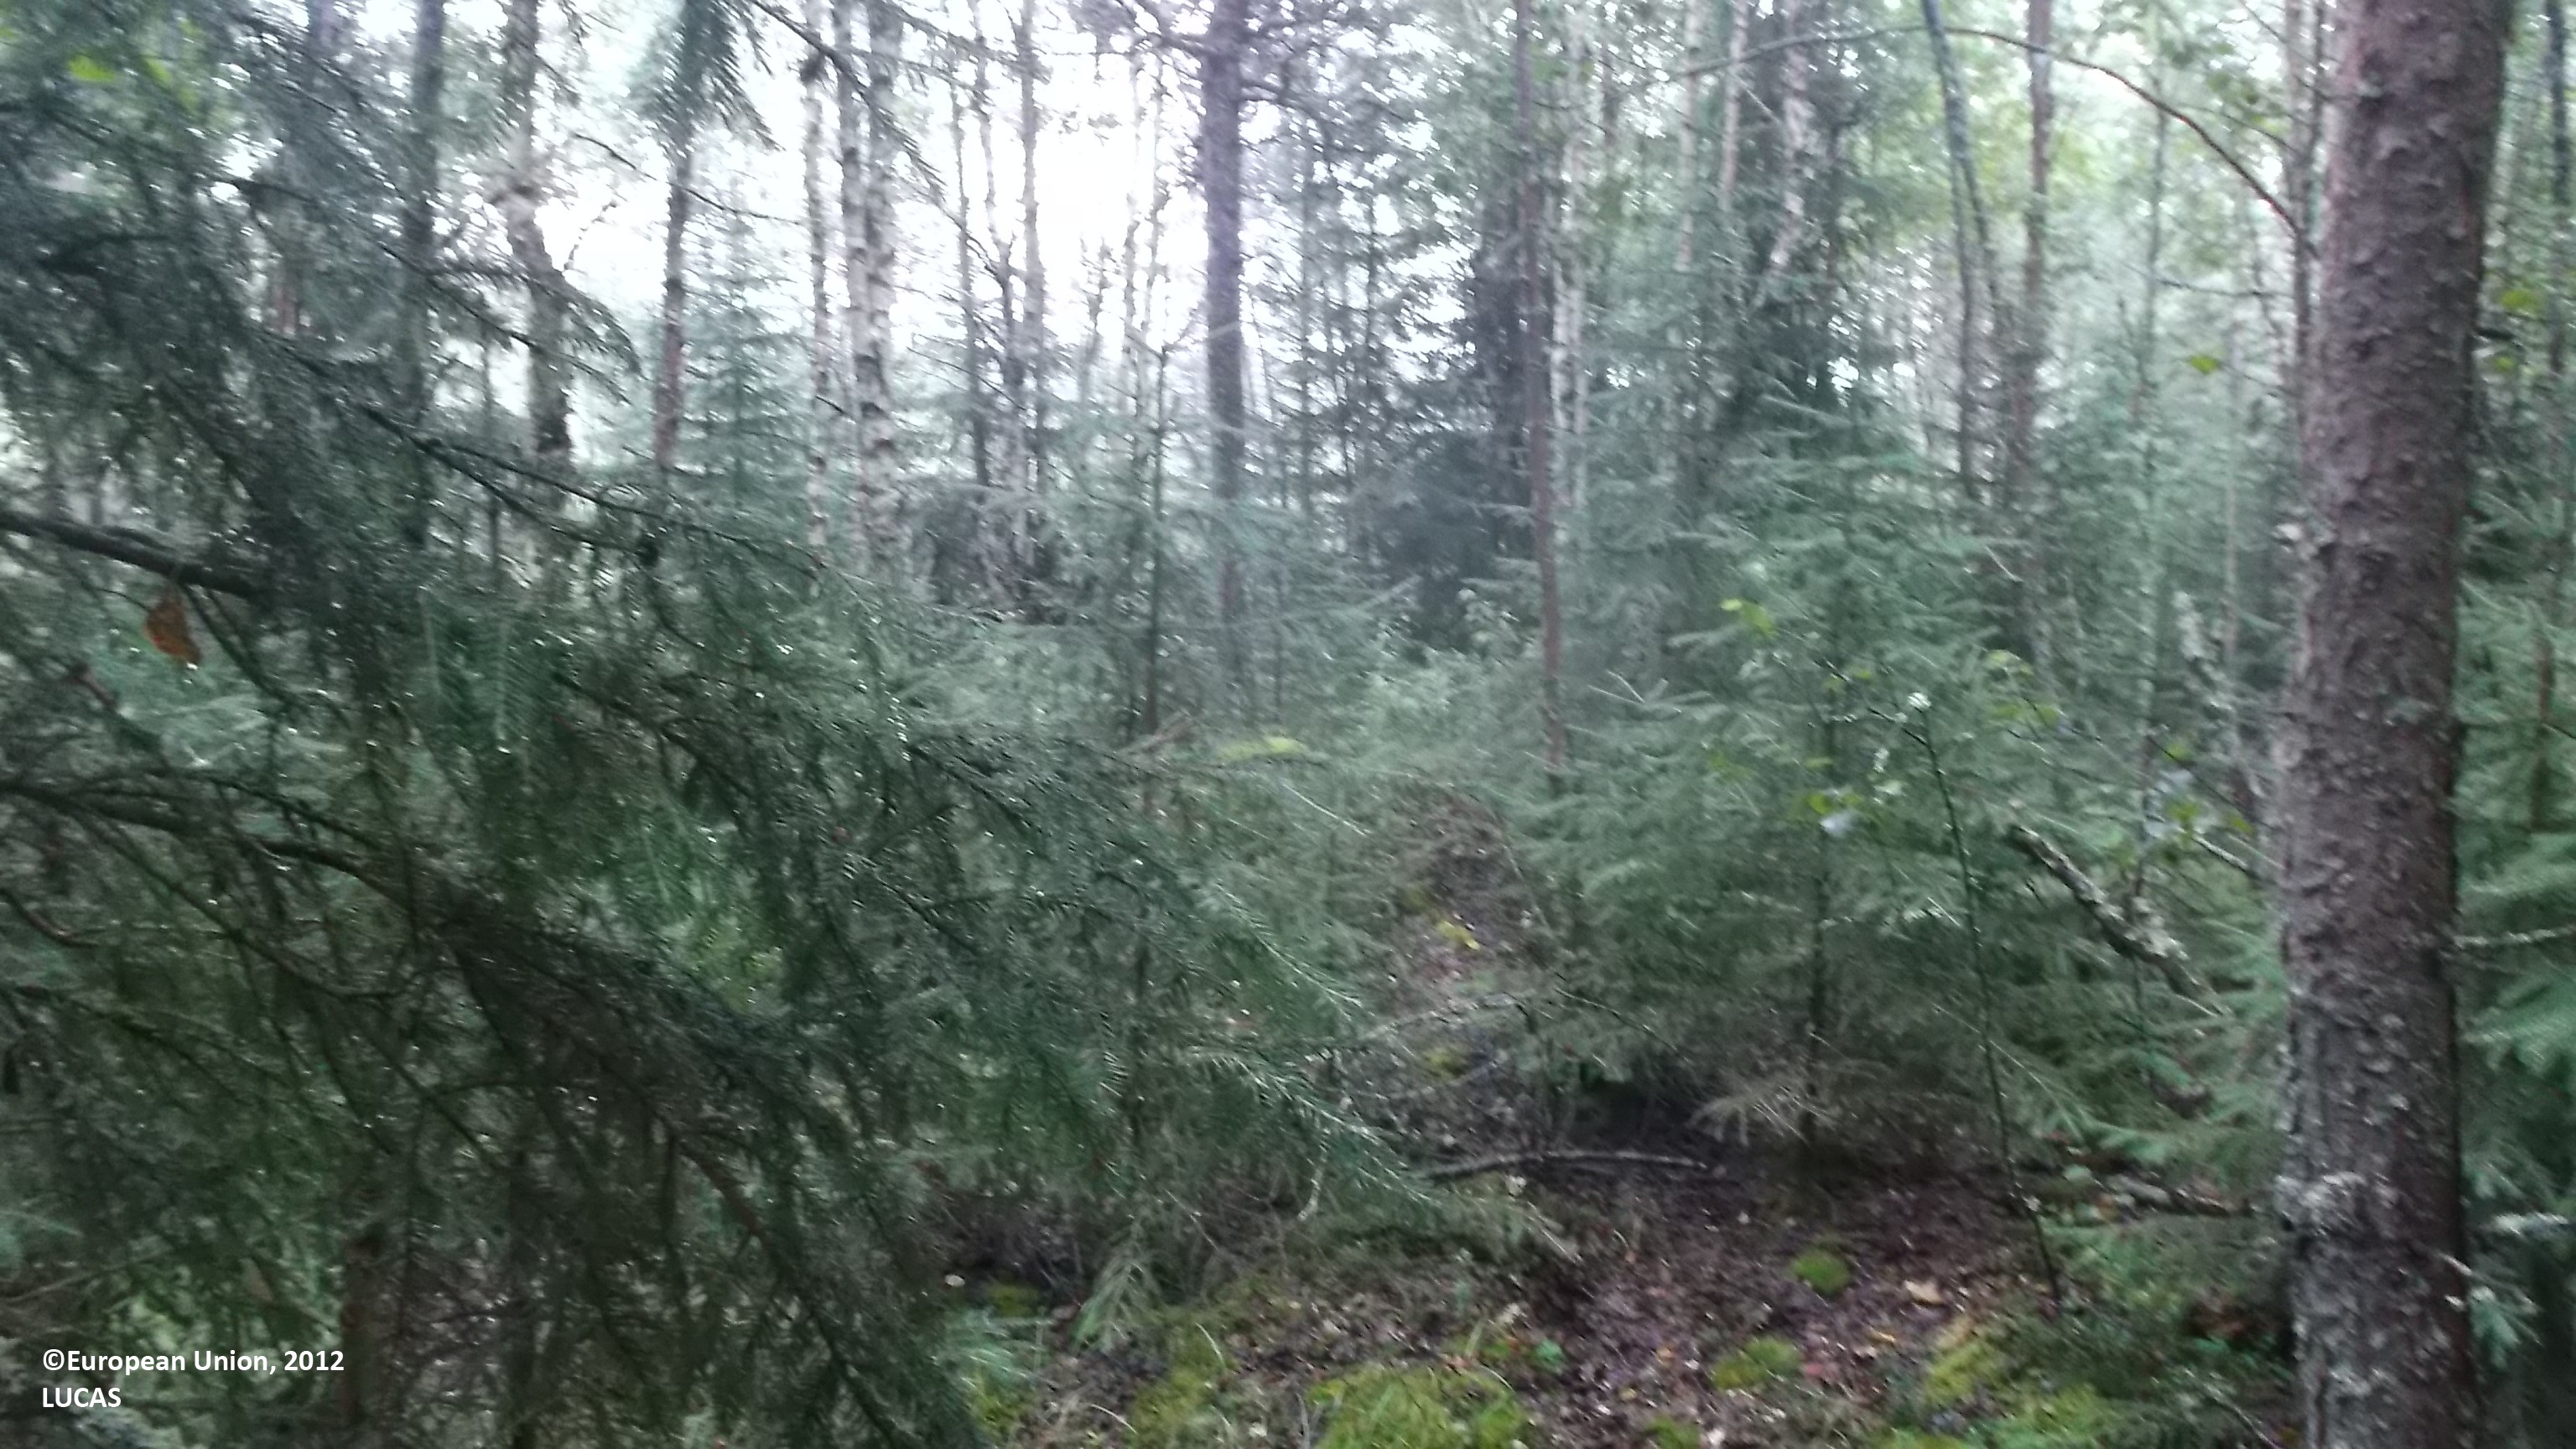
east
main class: Woodland
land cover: Other mixed woodland
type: boreal forest
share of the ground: > 75 %
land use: Forestry
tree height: > 5 m
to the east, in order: Other mixed woodland; Ditches and canals; Other mixed woodland; Peatbogs; Pine dominated coniferous woodland; Broadleaved woodland; Ditches and canals; Broadleaved woodland; Other mixed woodland; Ditches and canals; Other mixed woodland; Ditches and canals; Other mixed woodland; Pine dominated mixed woodland; Pine dominated coniferous woodland
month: August
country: FI
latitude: 63.8010
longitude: 23.2718
